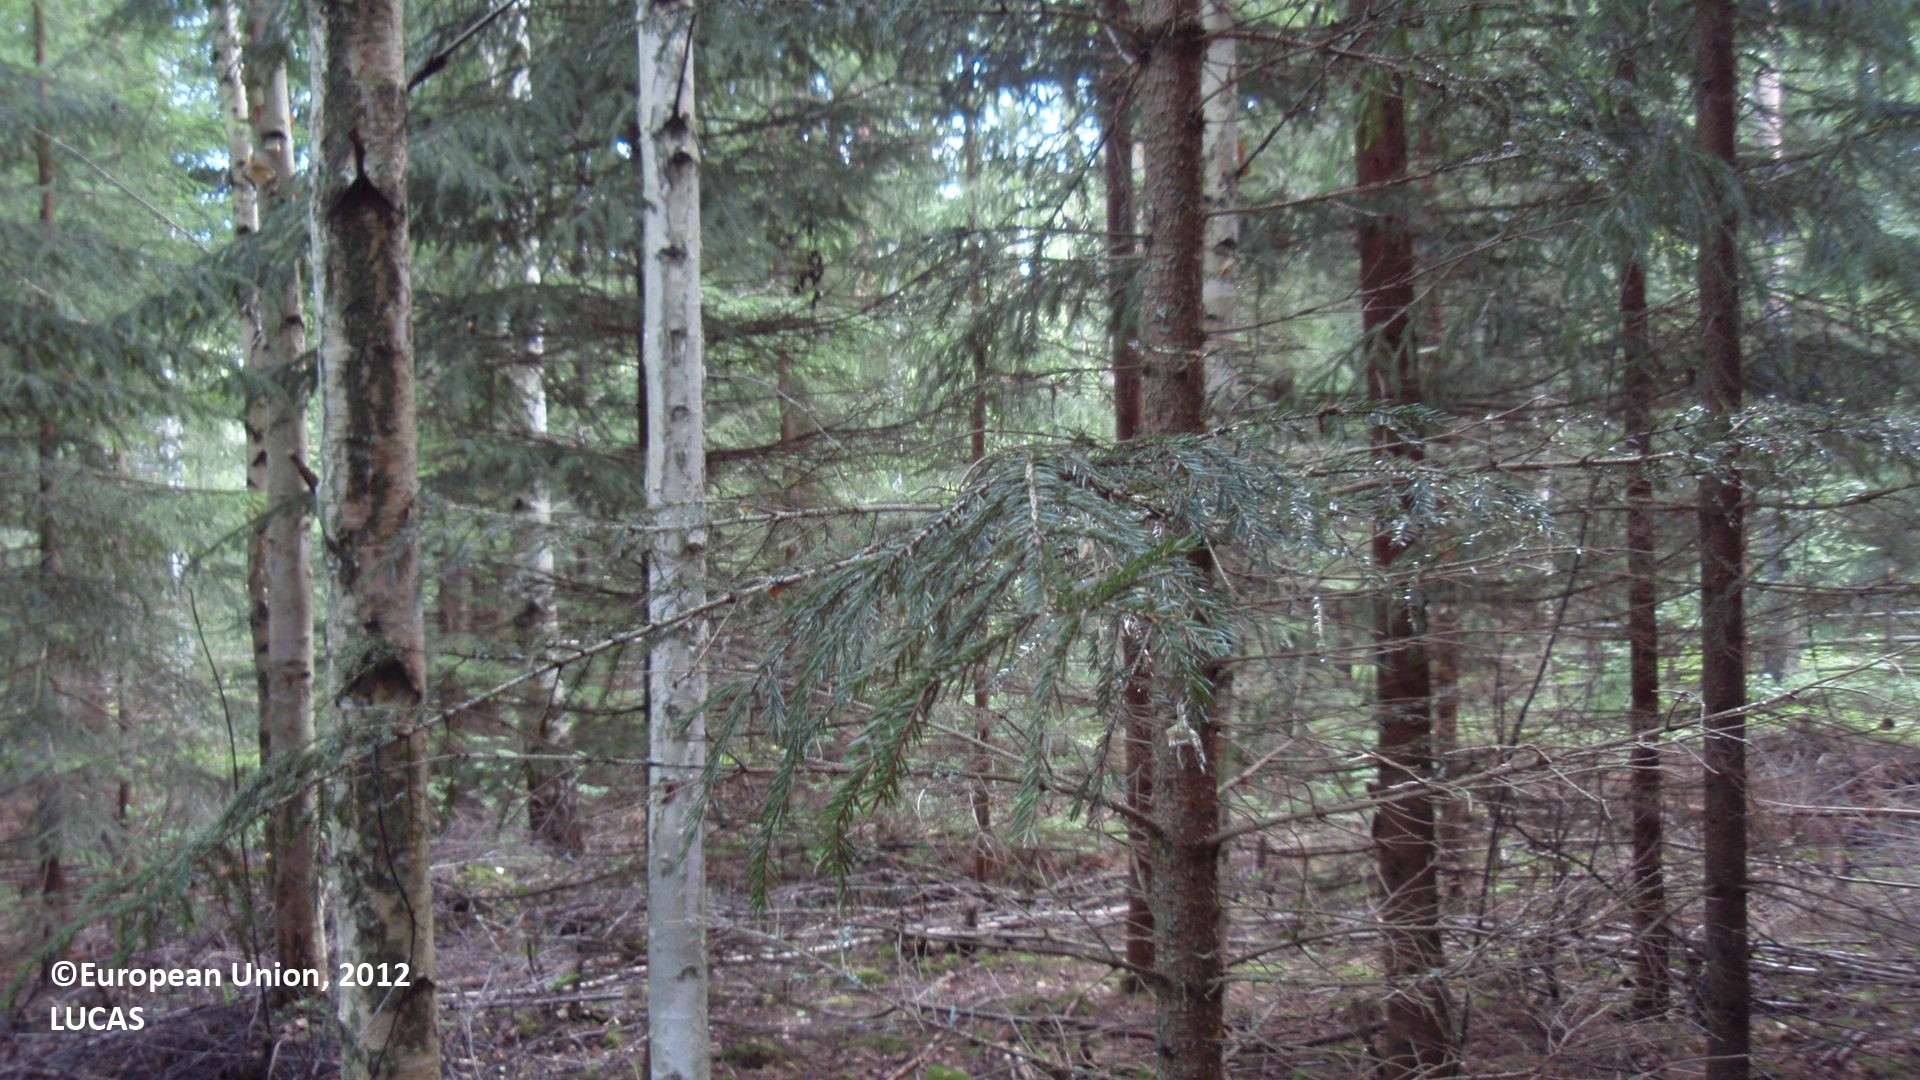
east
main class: Woodland
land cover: Spruce dominated mixed woodland
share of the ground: > 75 %
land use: Forestry
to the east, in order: Spruce dominated mixed woodland; Paved roads, cycling and walking lanes; Fences; Pine dominated mixed woodland; Spruce dominated coniferous woodland; Grass margins; Fences; Electric lines; Pine dominated mixed woodland; Other mixed woodland; Broadleaved woodland; Shrubland with sparse tree cover
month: August
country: FI
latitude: 61.3060
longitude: 27.7183
